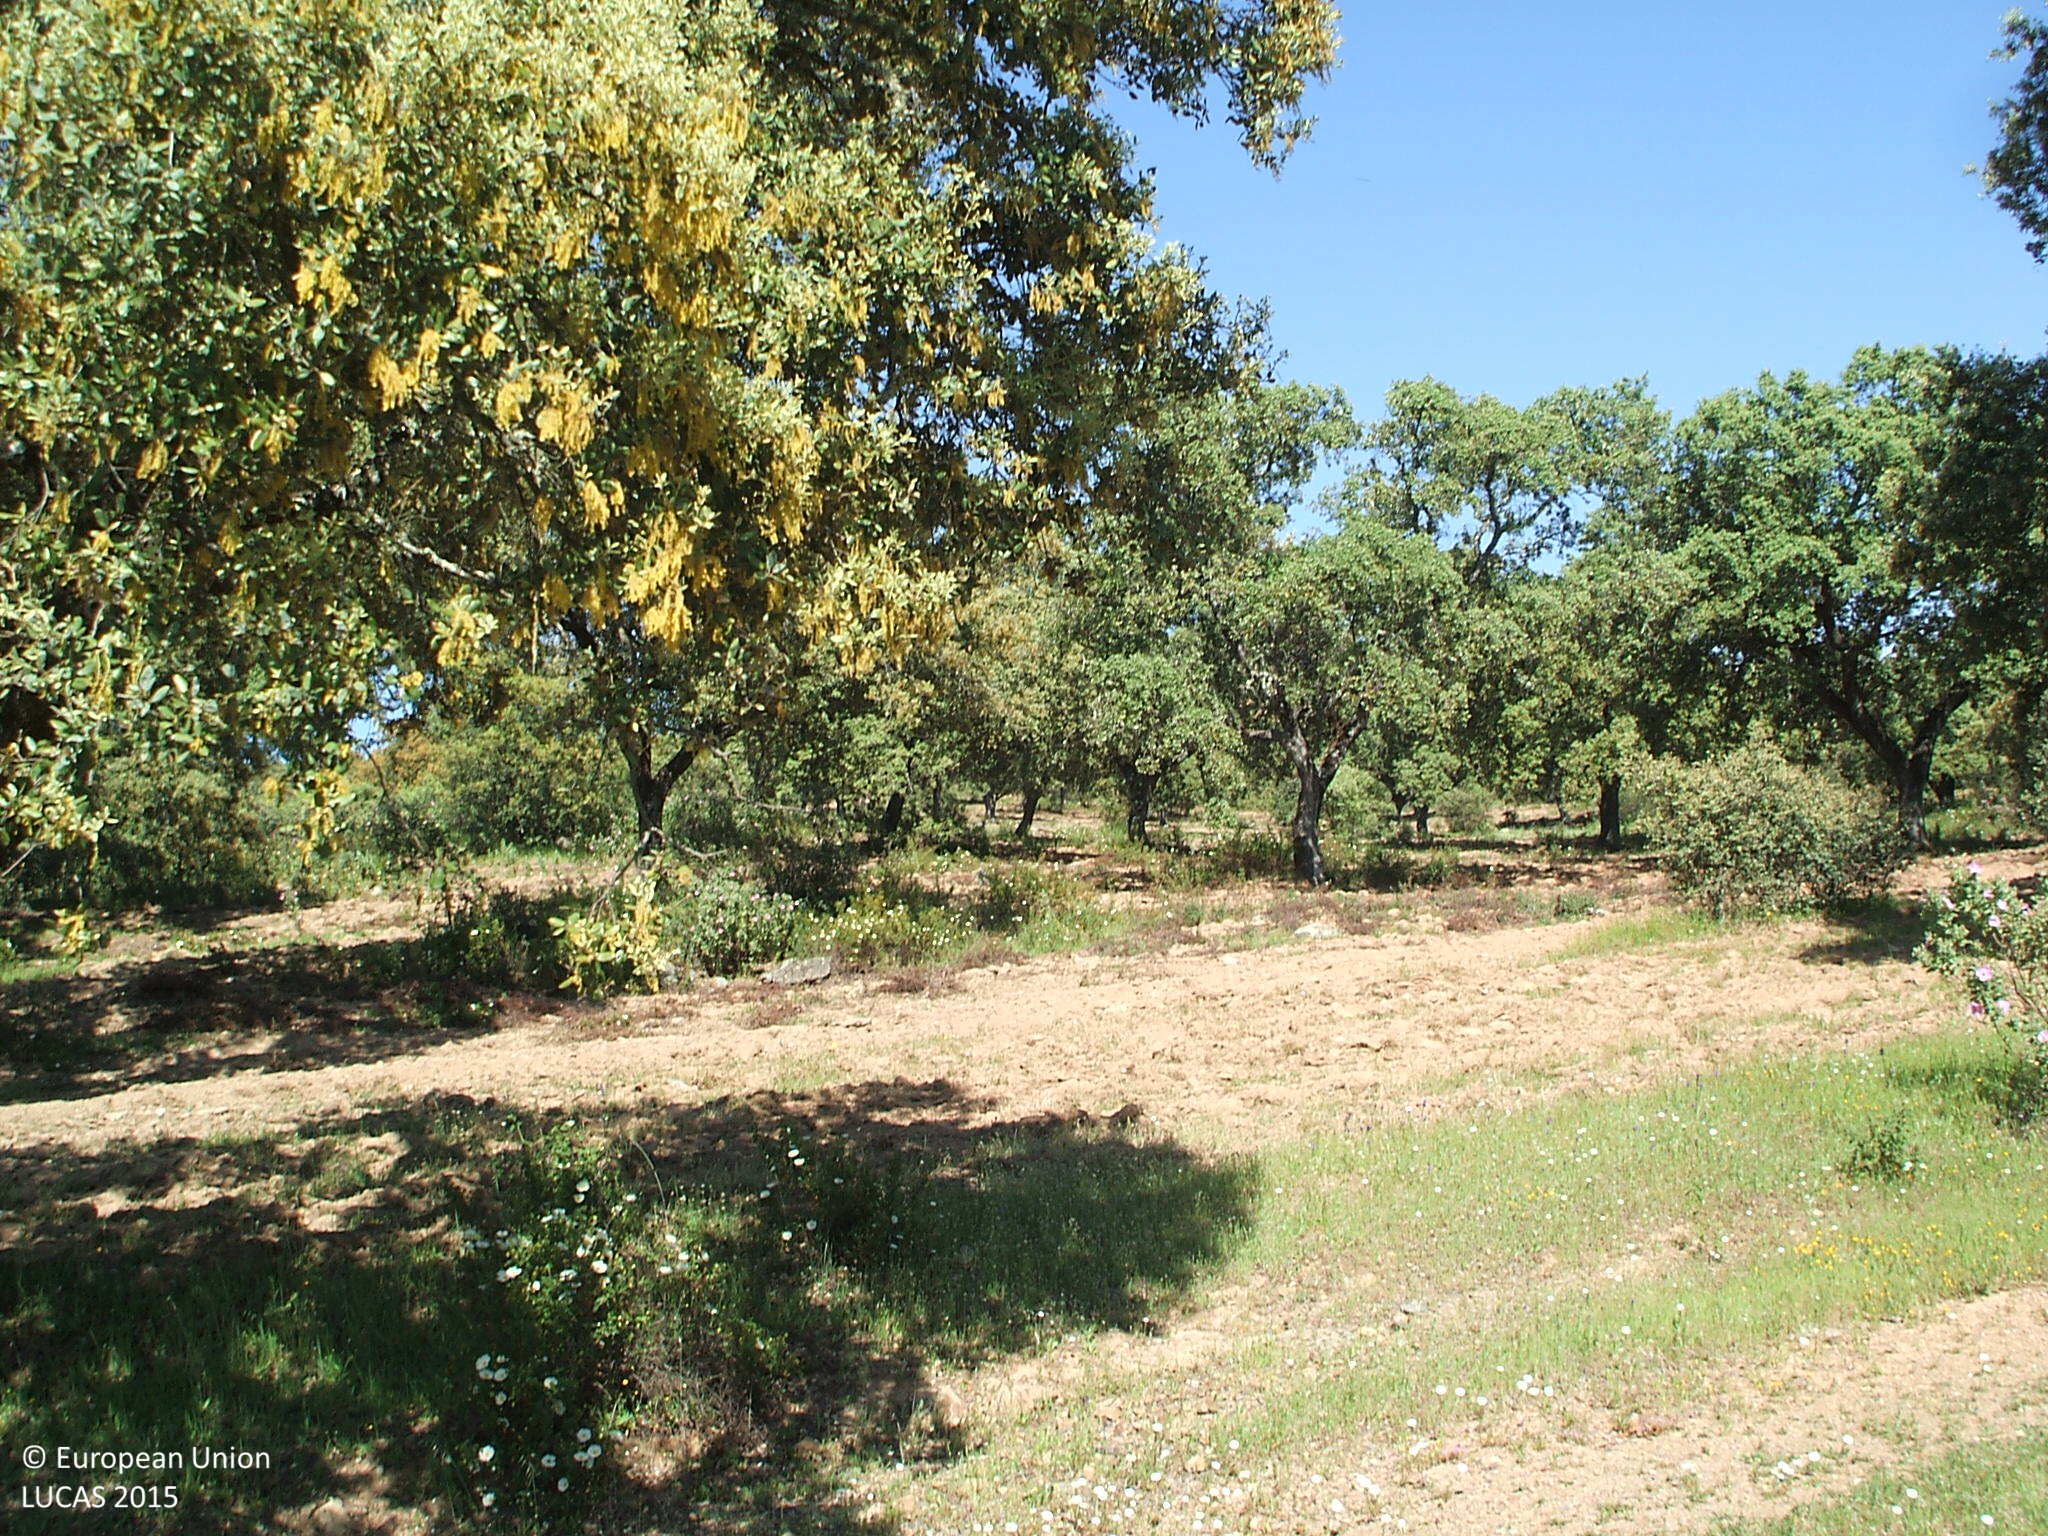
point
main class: Woodland
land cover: Broadleaved woodland
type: broadleaved evergreen forest
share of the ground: 50 - 75 %
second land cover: Grassland without tree/shrub cover
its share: > 75 %
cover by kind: broadleaved forest trees 50 %, herbaceous plants 50 %
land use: Forestry
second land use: Agriculture (excluding fallow land and kitchen gardens)
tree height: > 5 m
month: April
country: ES
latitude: 38.0128
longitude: -5.7377
